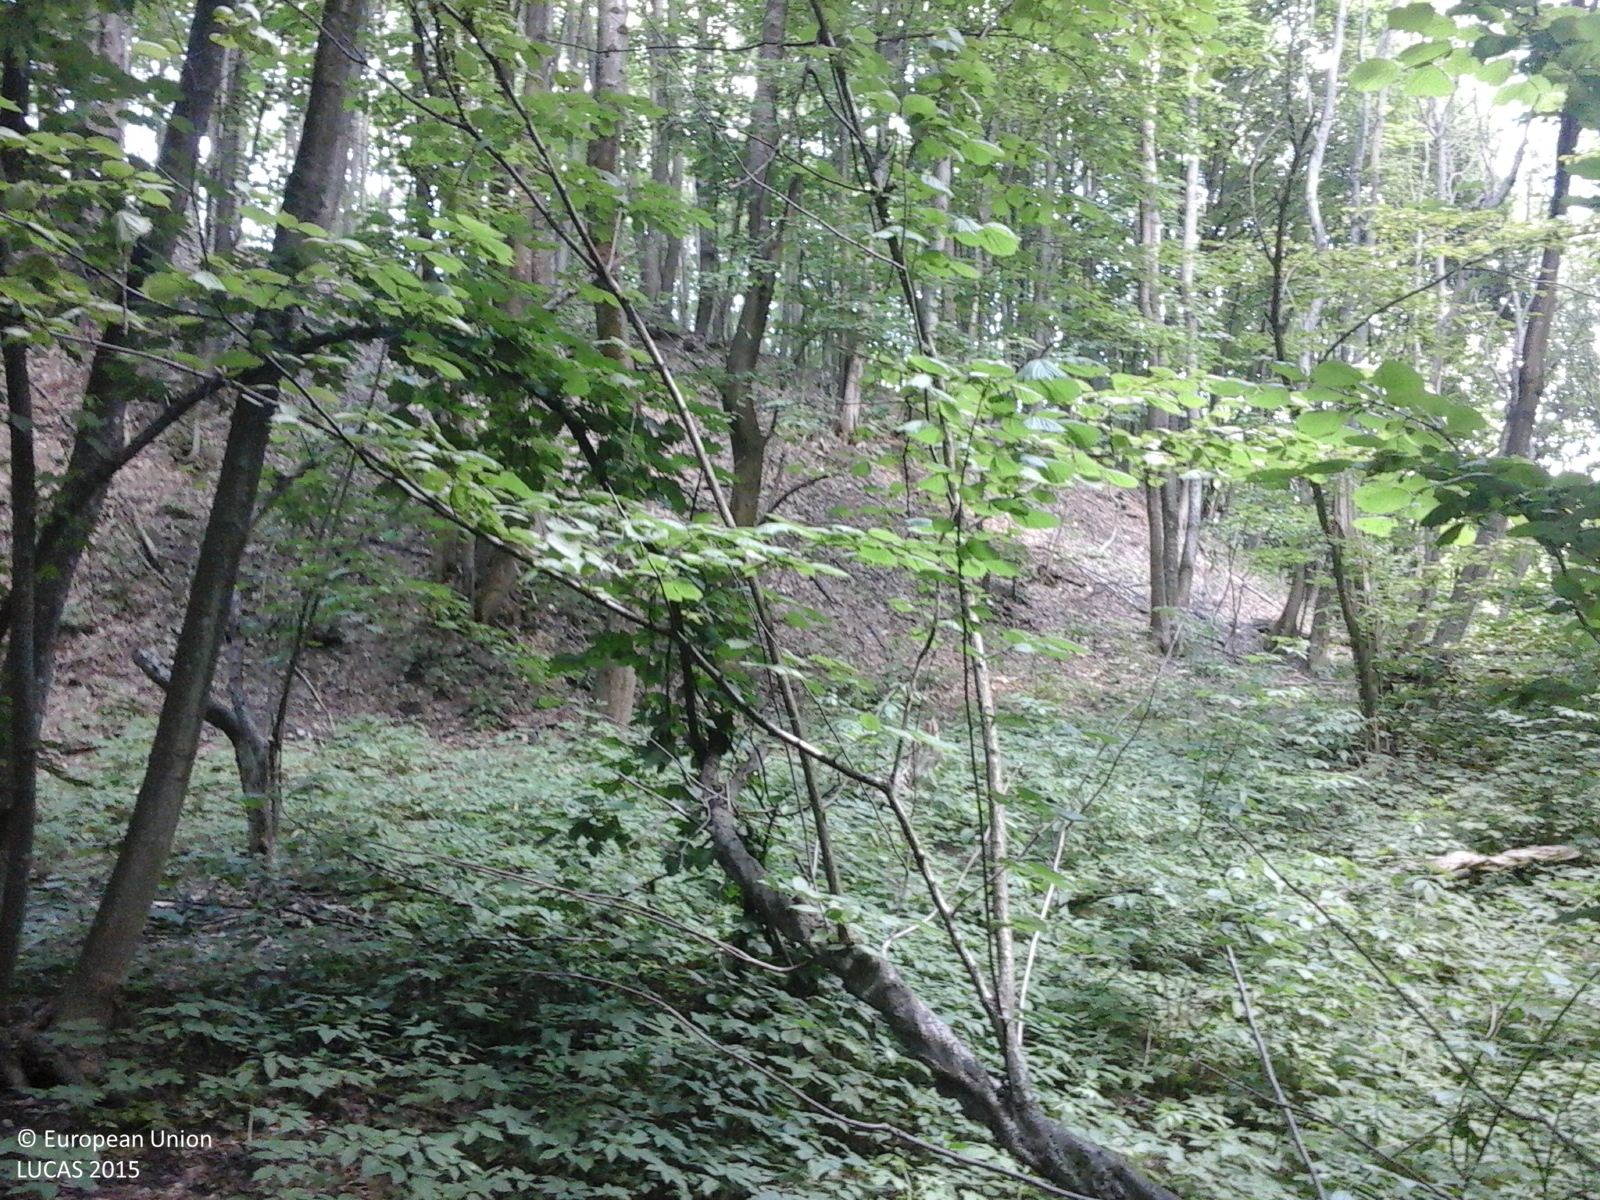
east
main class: Woodland
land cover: Broadleaved woodland
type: mesophytic deciduous forest
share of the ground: > 75 %
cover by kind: broadleaved forest trees 100 %
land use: Forestry
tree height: > 5 m
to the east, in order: Broadleaved woodland; Grassland with sparse tree/shrub cover
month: June
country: RO
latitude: 46.9959
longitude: 27.5940
